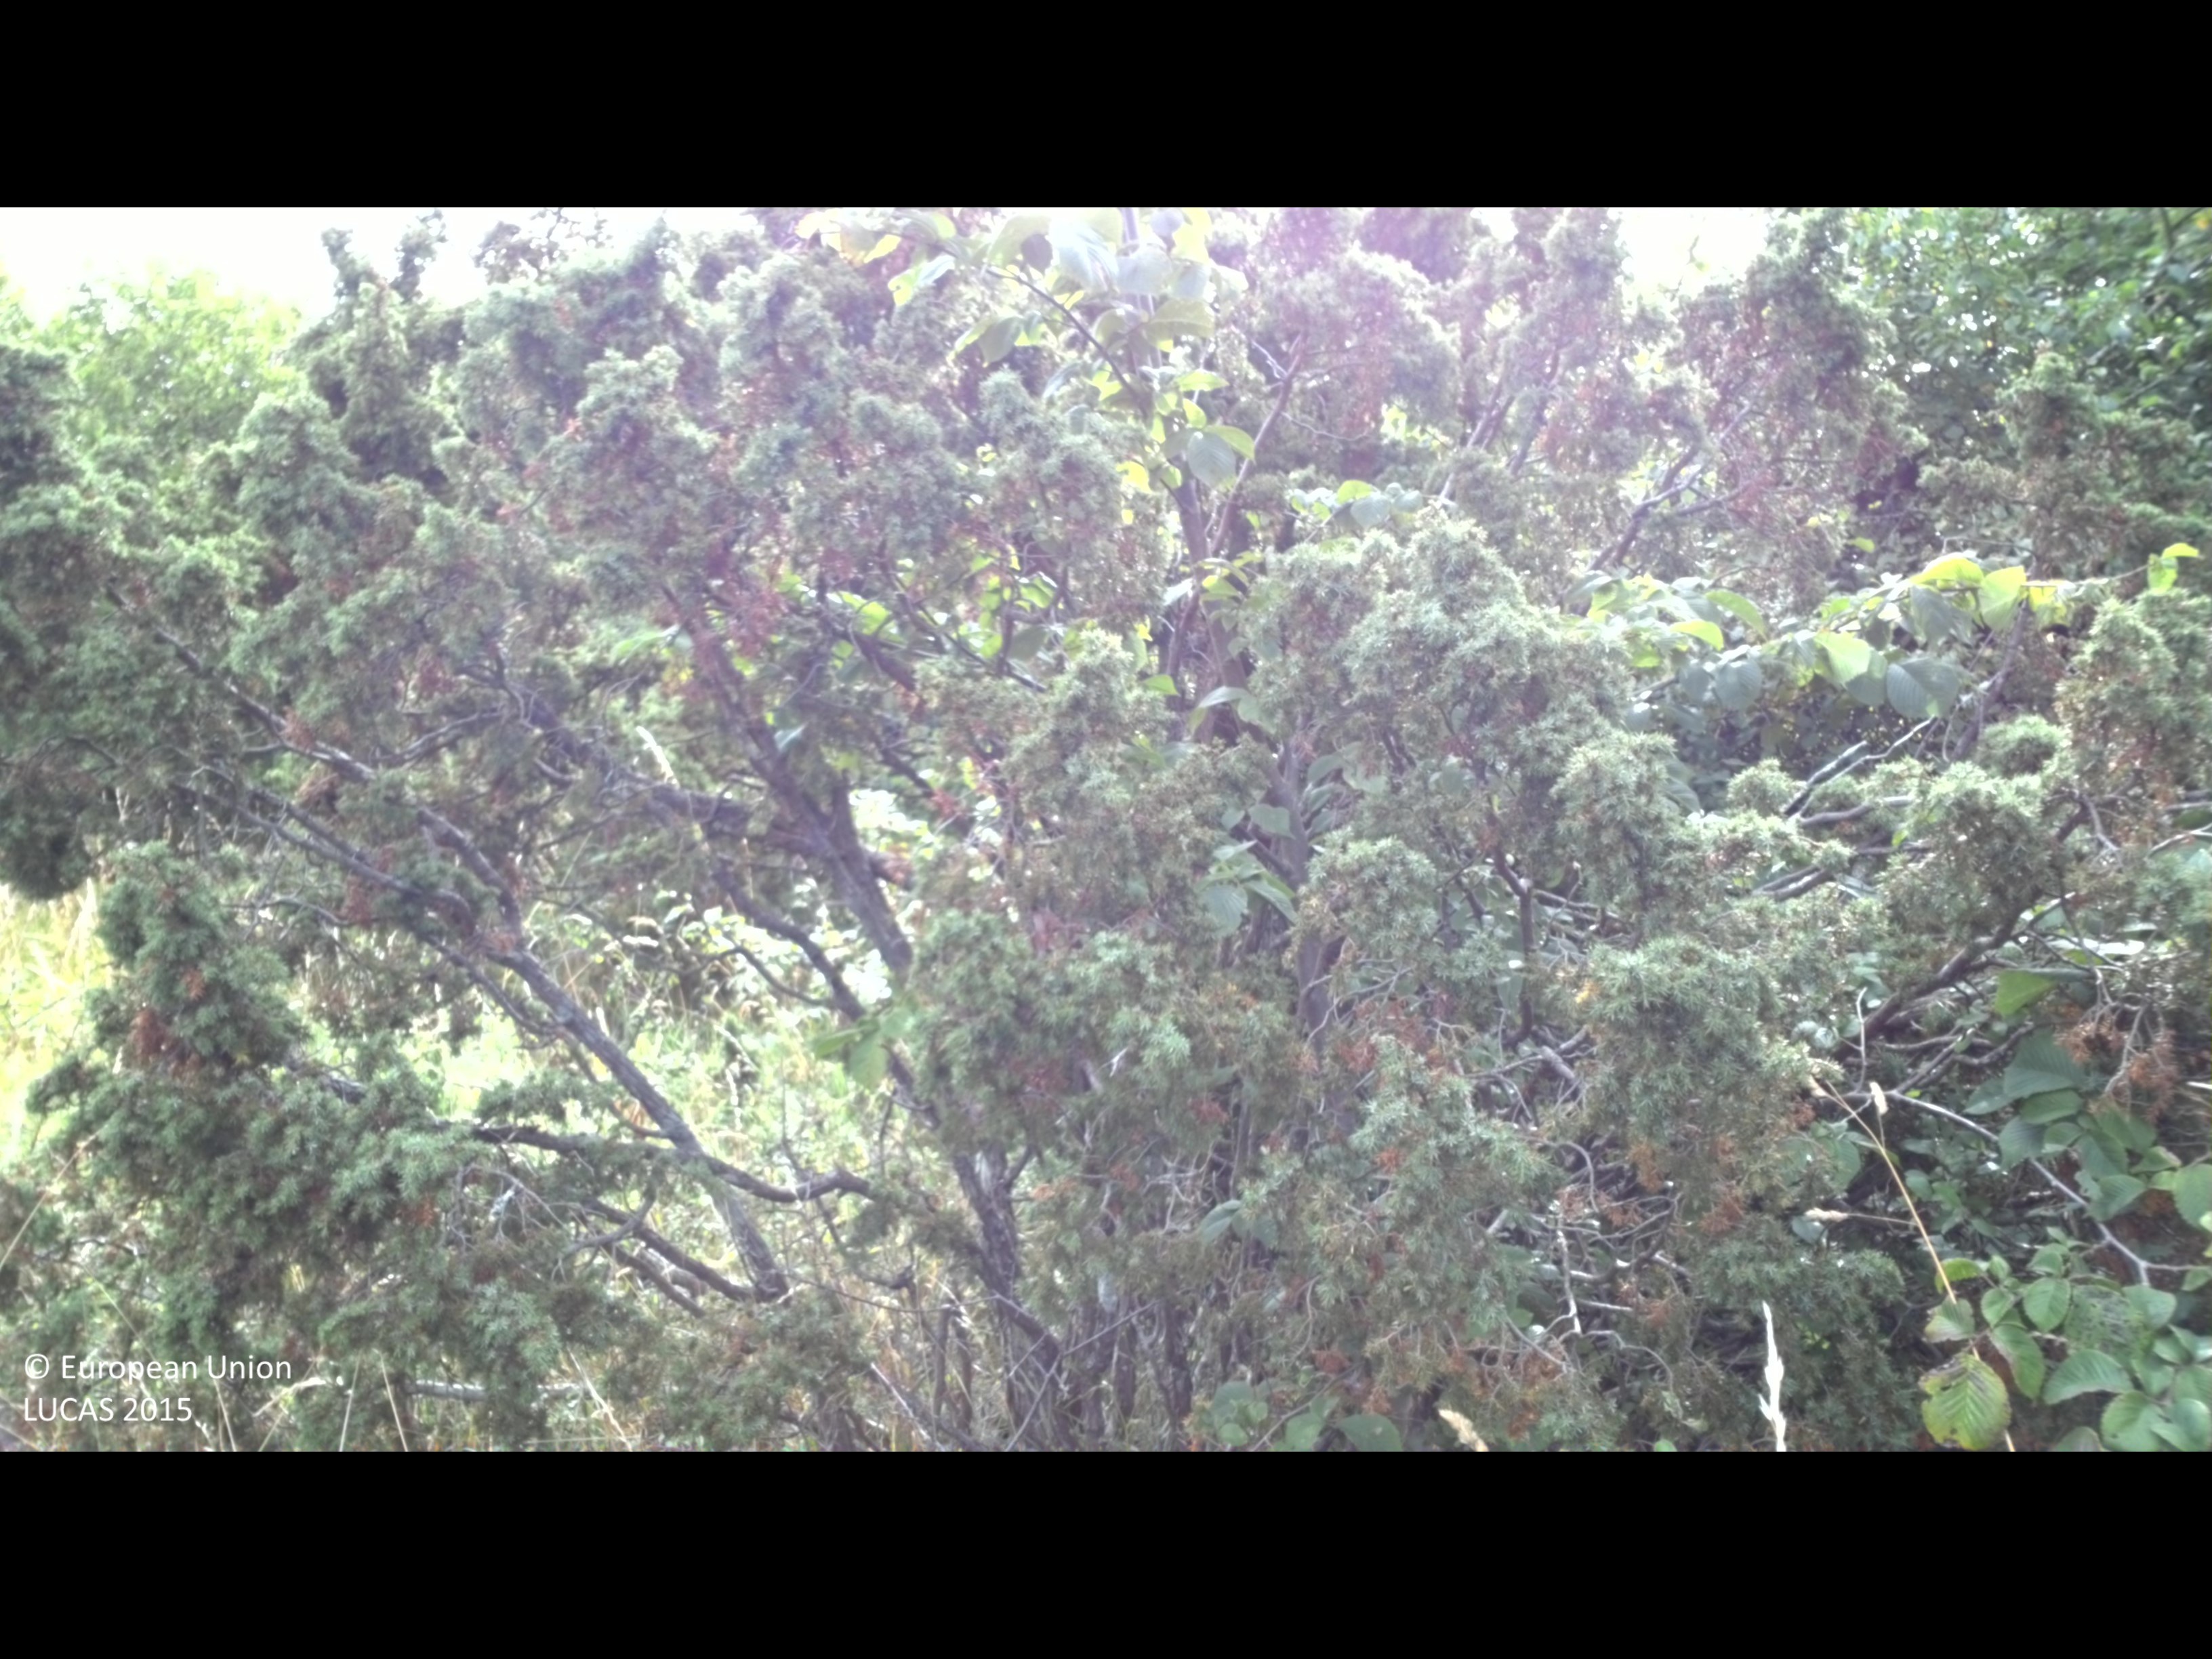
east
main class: Shrubland
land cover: Shrubland with sparse tree cover
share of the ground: > 75 %
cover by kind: shrubs 90 %, broadleaved forest trees 5 %, herbaceous plants 5 %
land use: Semi-natural and natural areas not in use
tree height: < 5 m
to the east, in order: Shrubland with sparse tree cover; Grassland with sparse tree/shrub cover; Grassland without tree/shrub cover; Grassland with sparse tree/shrub cover; Groves; Fences; Grassland without tree/shrub cover; Dry stone walls; Grassland without tree/shrub cover
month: July
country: SE
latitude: 56.8459
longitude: 16.6414
